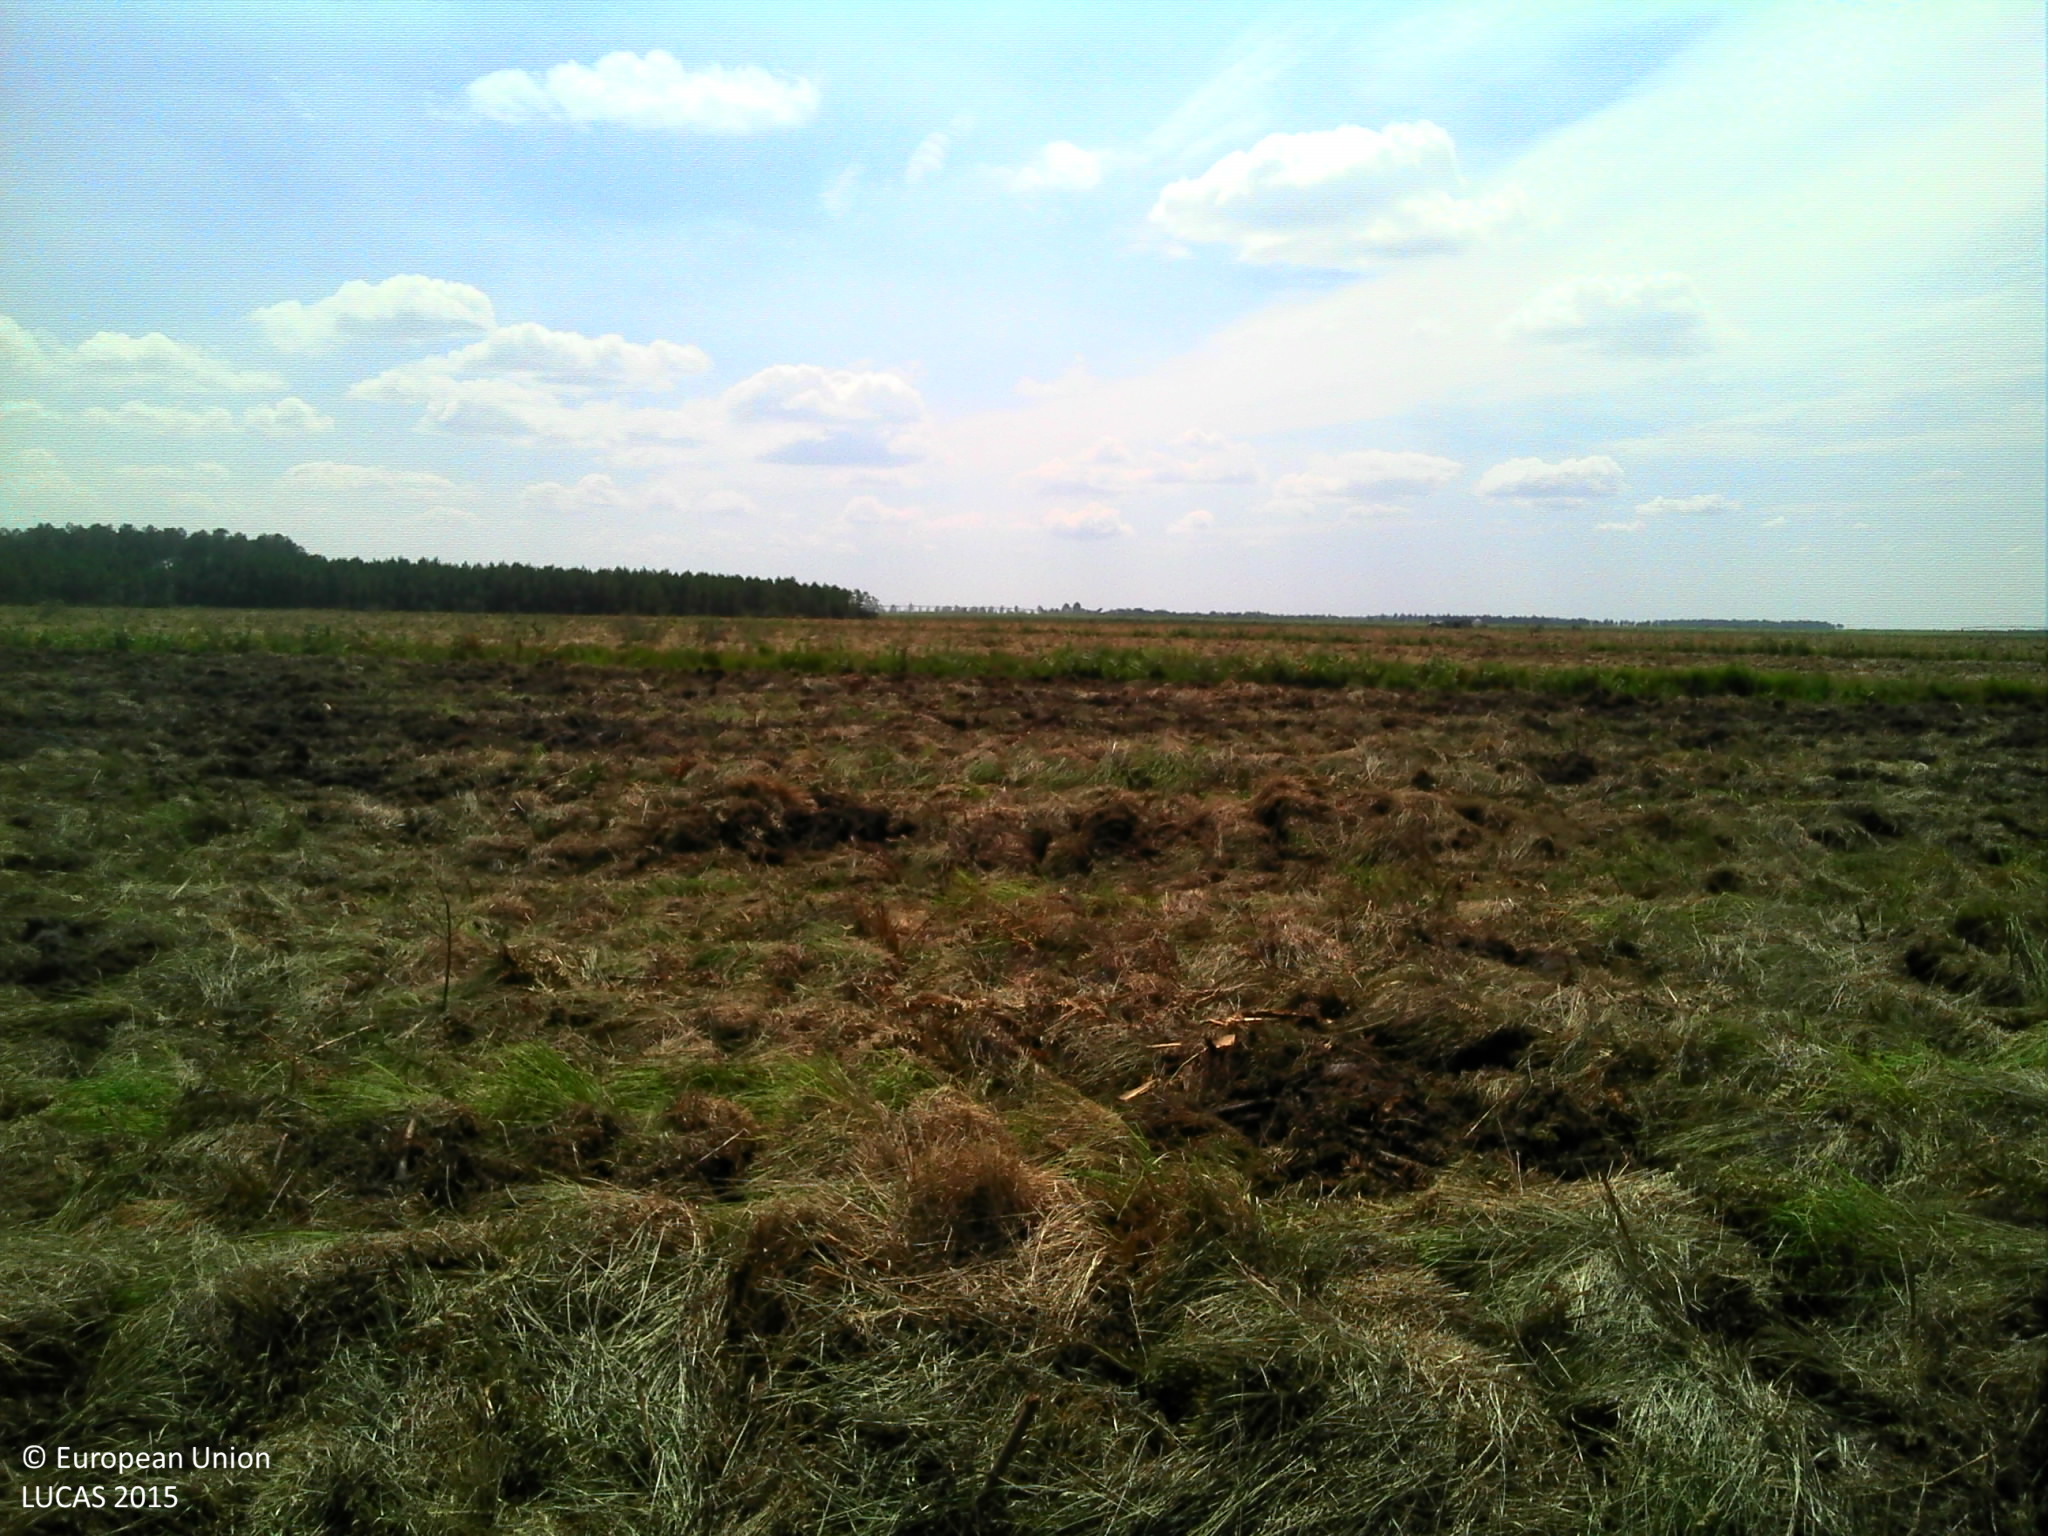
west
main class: Grassland
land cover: Spontaneously vegetated surfaces
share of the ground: > 75 %
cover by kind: herbaceous plants 100 %
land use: Forestry
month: July
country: FR
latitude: 44.2198
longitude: -0.6424
